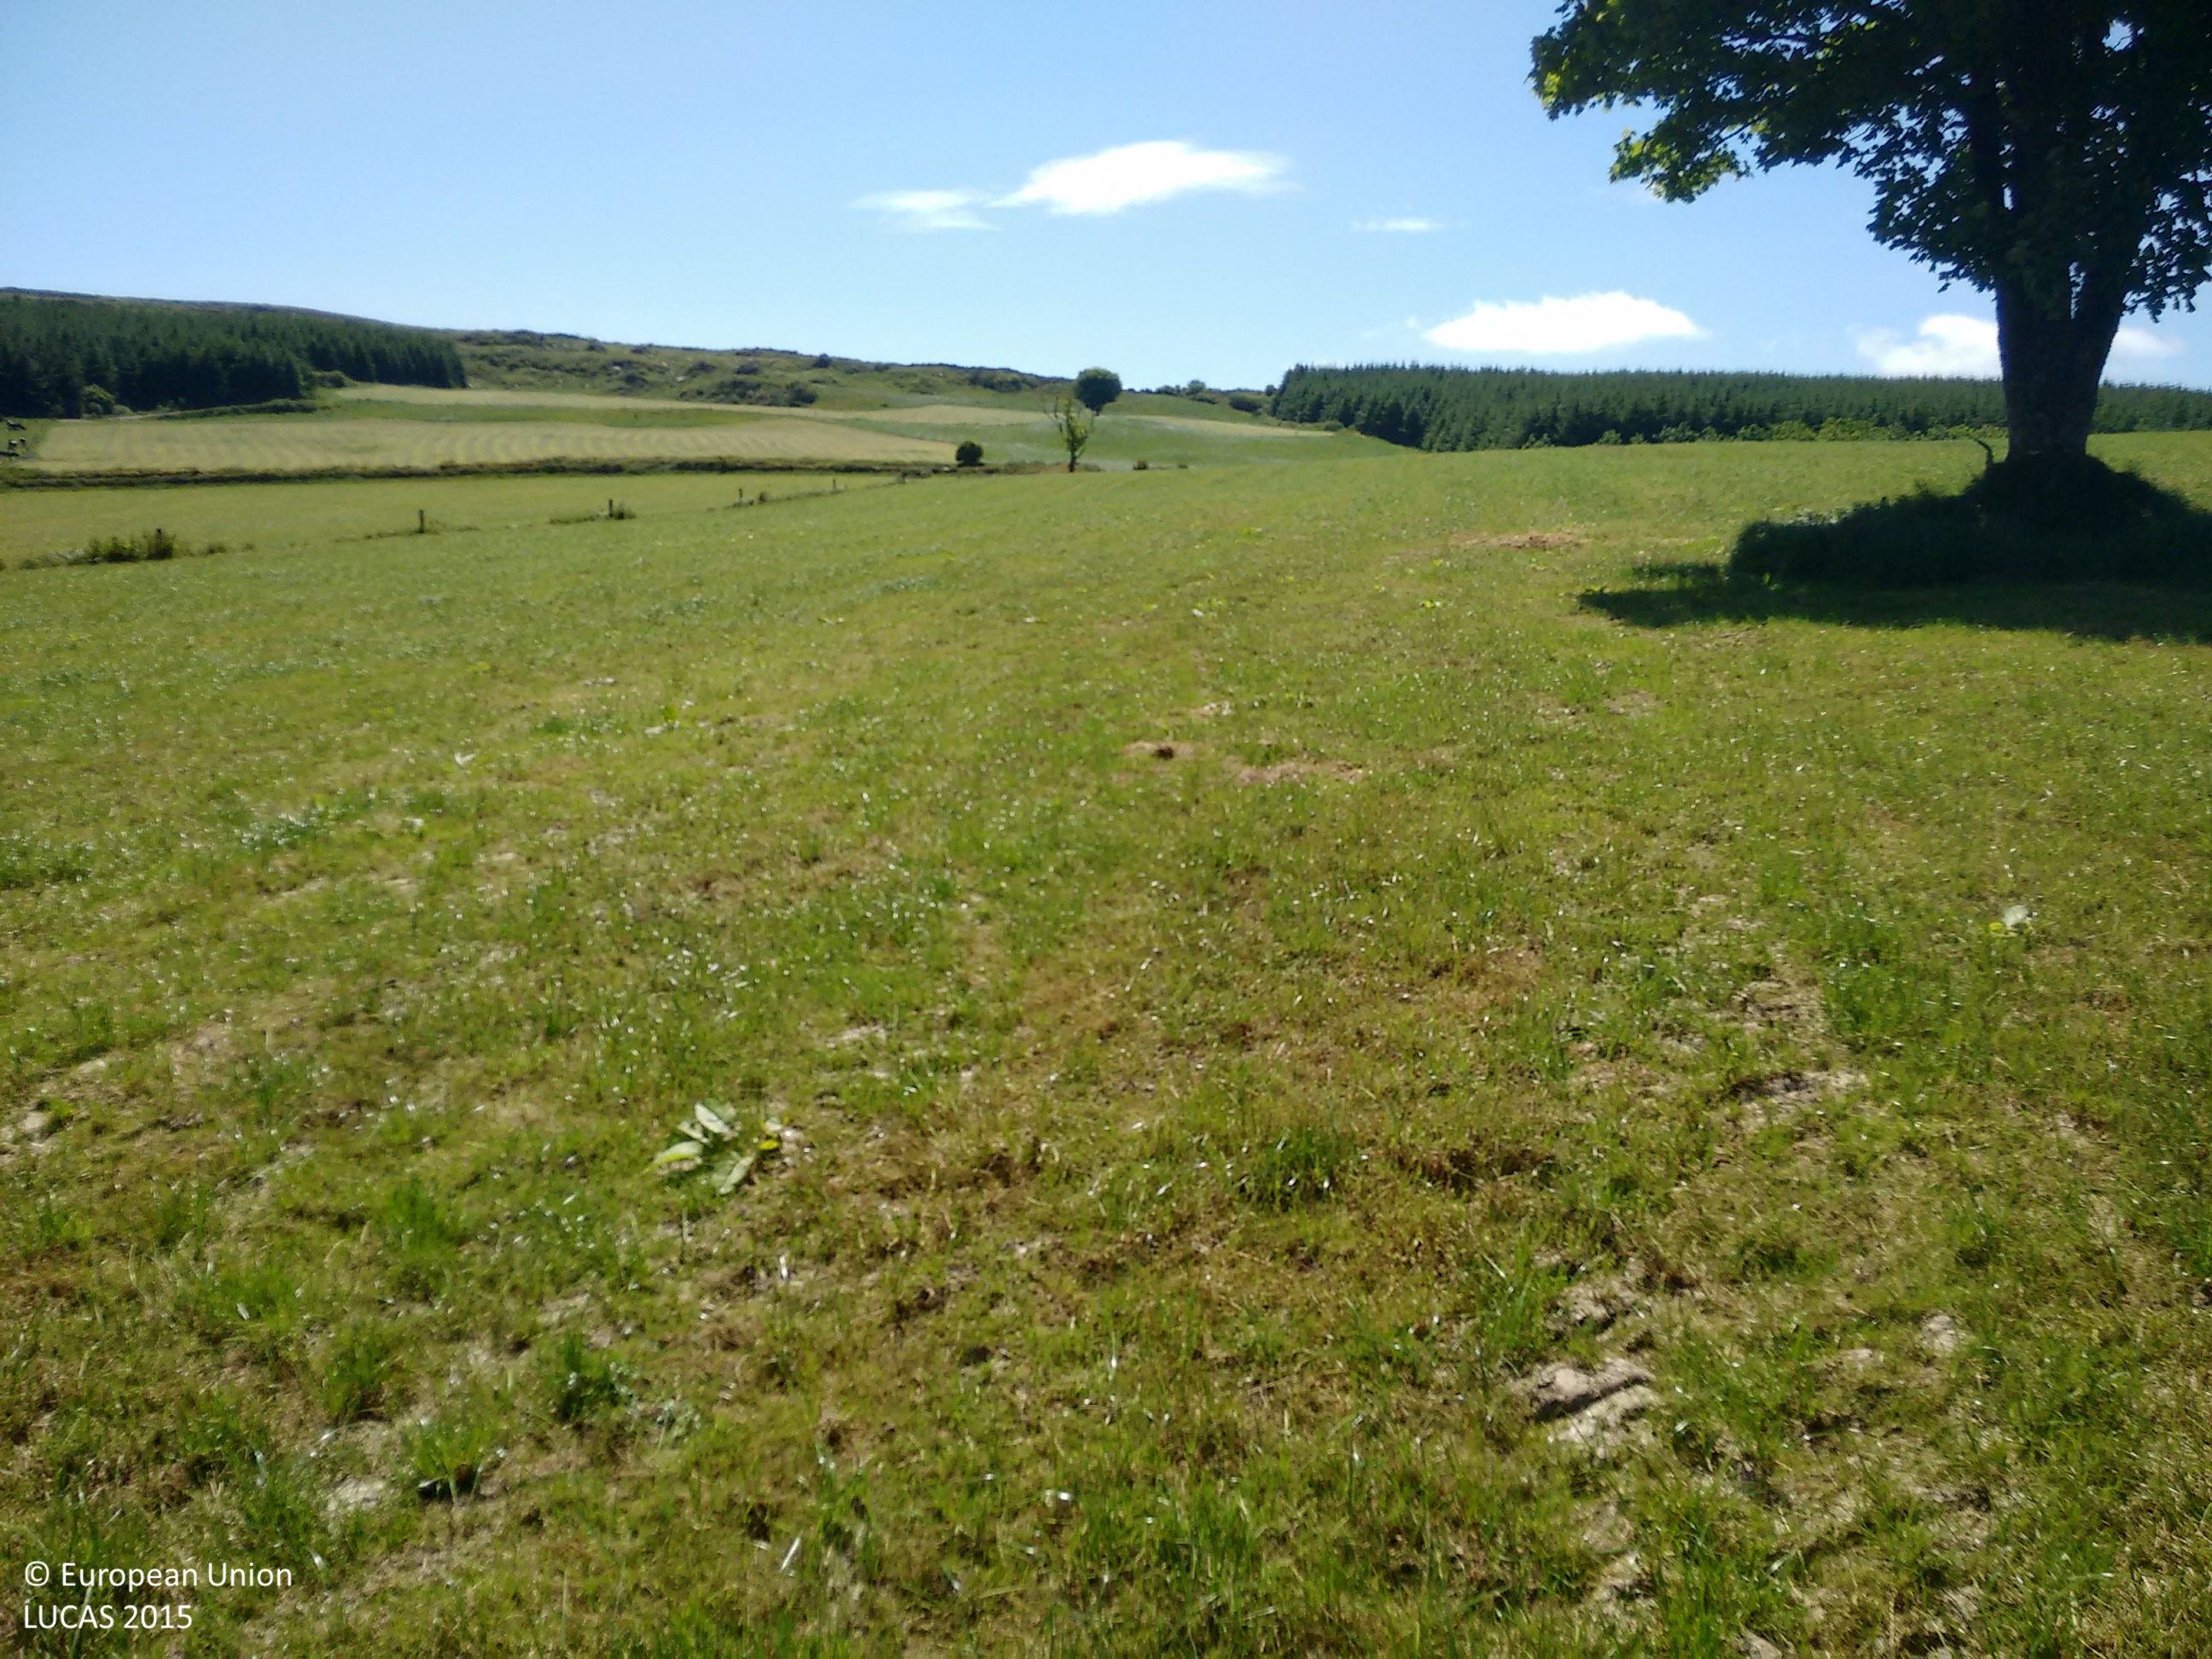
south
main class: Grassland
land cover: Grassland without tree/shrub cover
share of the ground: > 75 %
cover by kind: herbaceous plants 80 %, unconsolidated bare surface 20 %
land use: Agriculture (excluding fallow land and kitchen gardens)
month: June
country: IE
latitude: 51.9680
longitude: -9.0042
